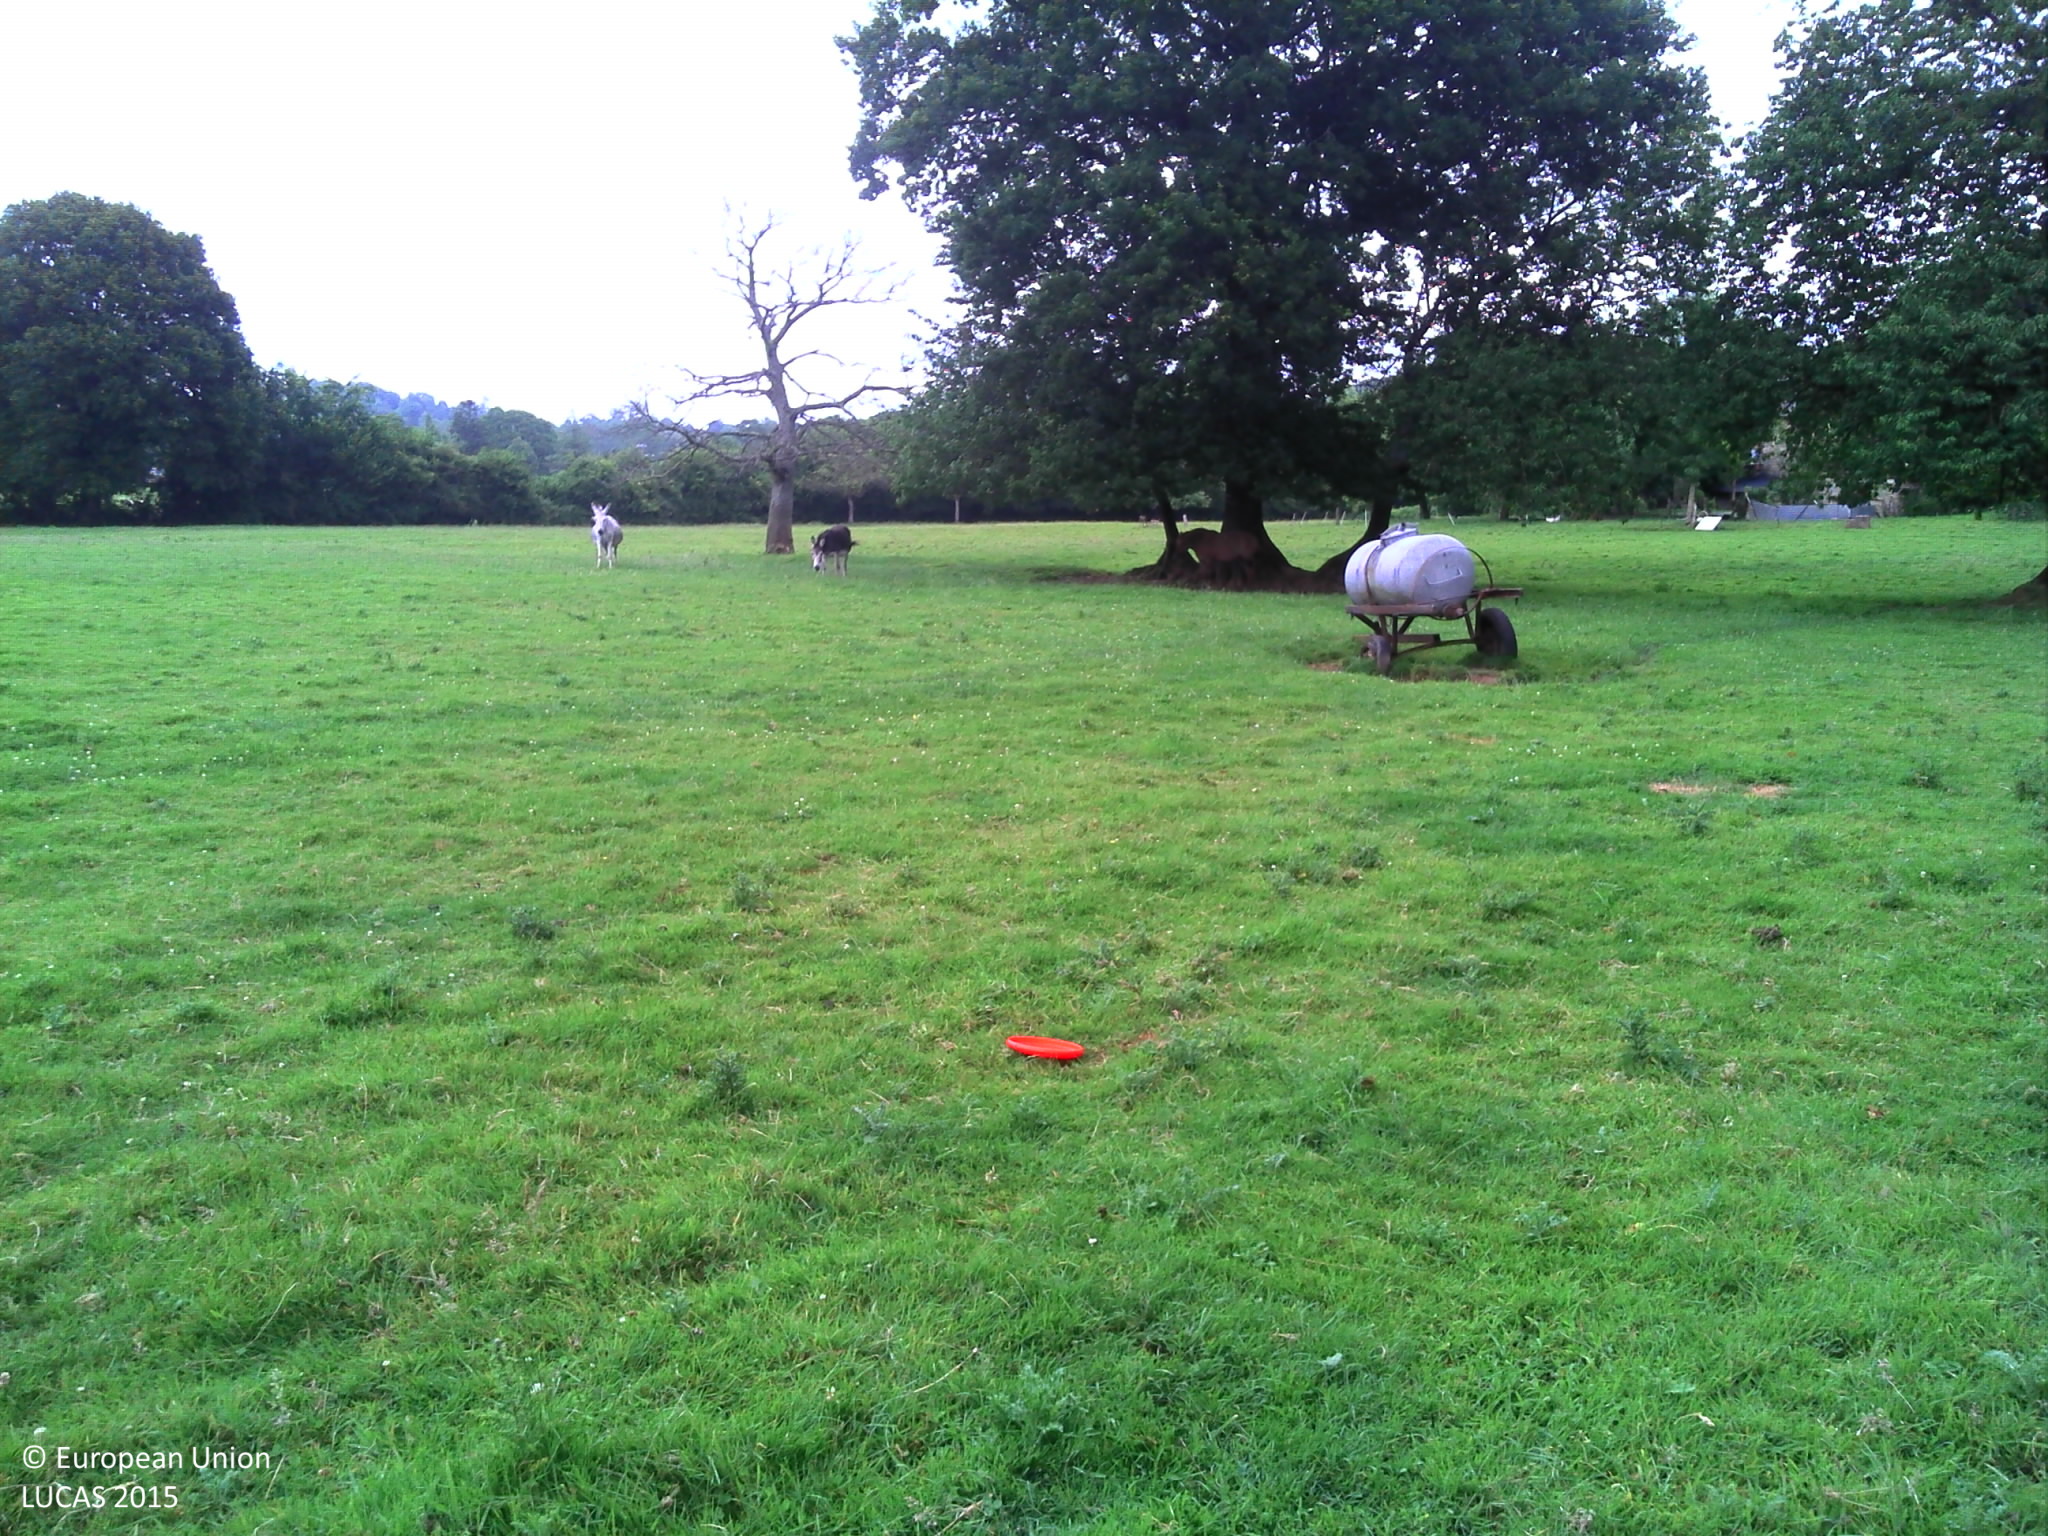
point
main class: Grassland
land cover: Grassland without tree/shrub cover
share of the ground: > 75 %
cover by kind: herbaceous plants 100 %
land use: Agriculture (excluding fallow land and kitchen gardens)
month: July
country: FR
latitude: 49.1043
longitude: -1.3748
